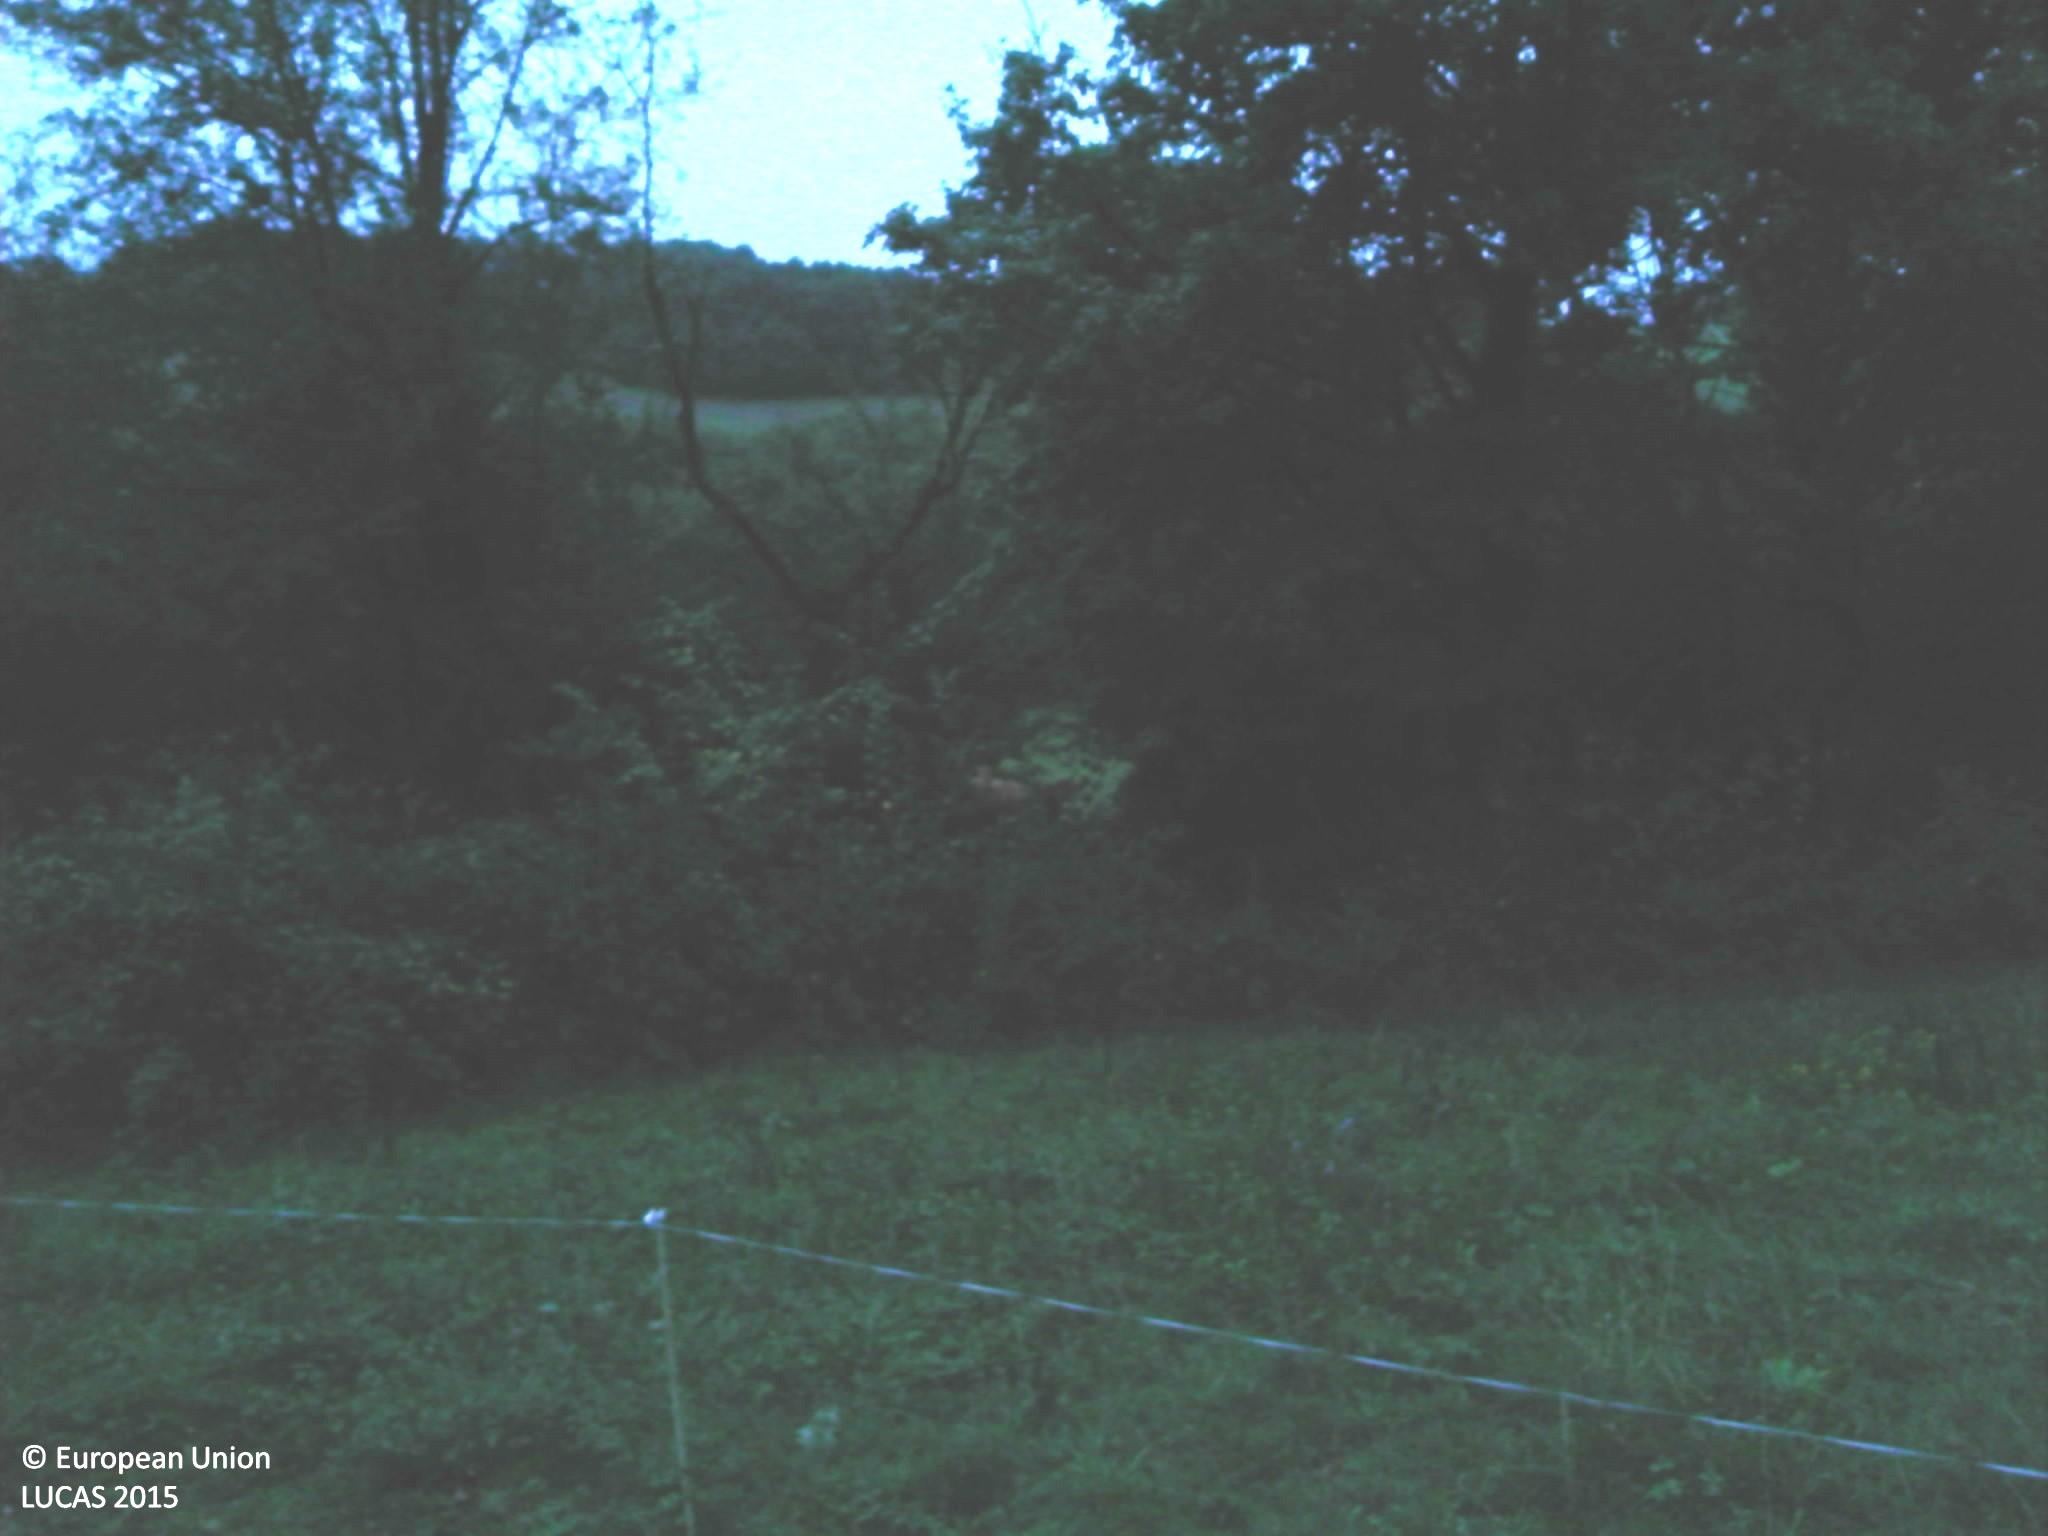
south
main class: Grassland
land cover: Grassland without tree/shrub cover
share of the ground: 50 - 75 %
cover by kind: herbaceous plants 70 %, unconsolidated bare surface 30 %
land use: Agriculture (excluding fallow land and kitchen gardens)
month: September
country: FR
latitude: 46.5457
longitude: 1.6047
